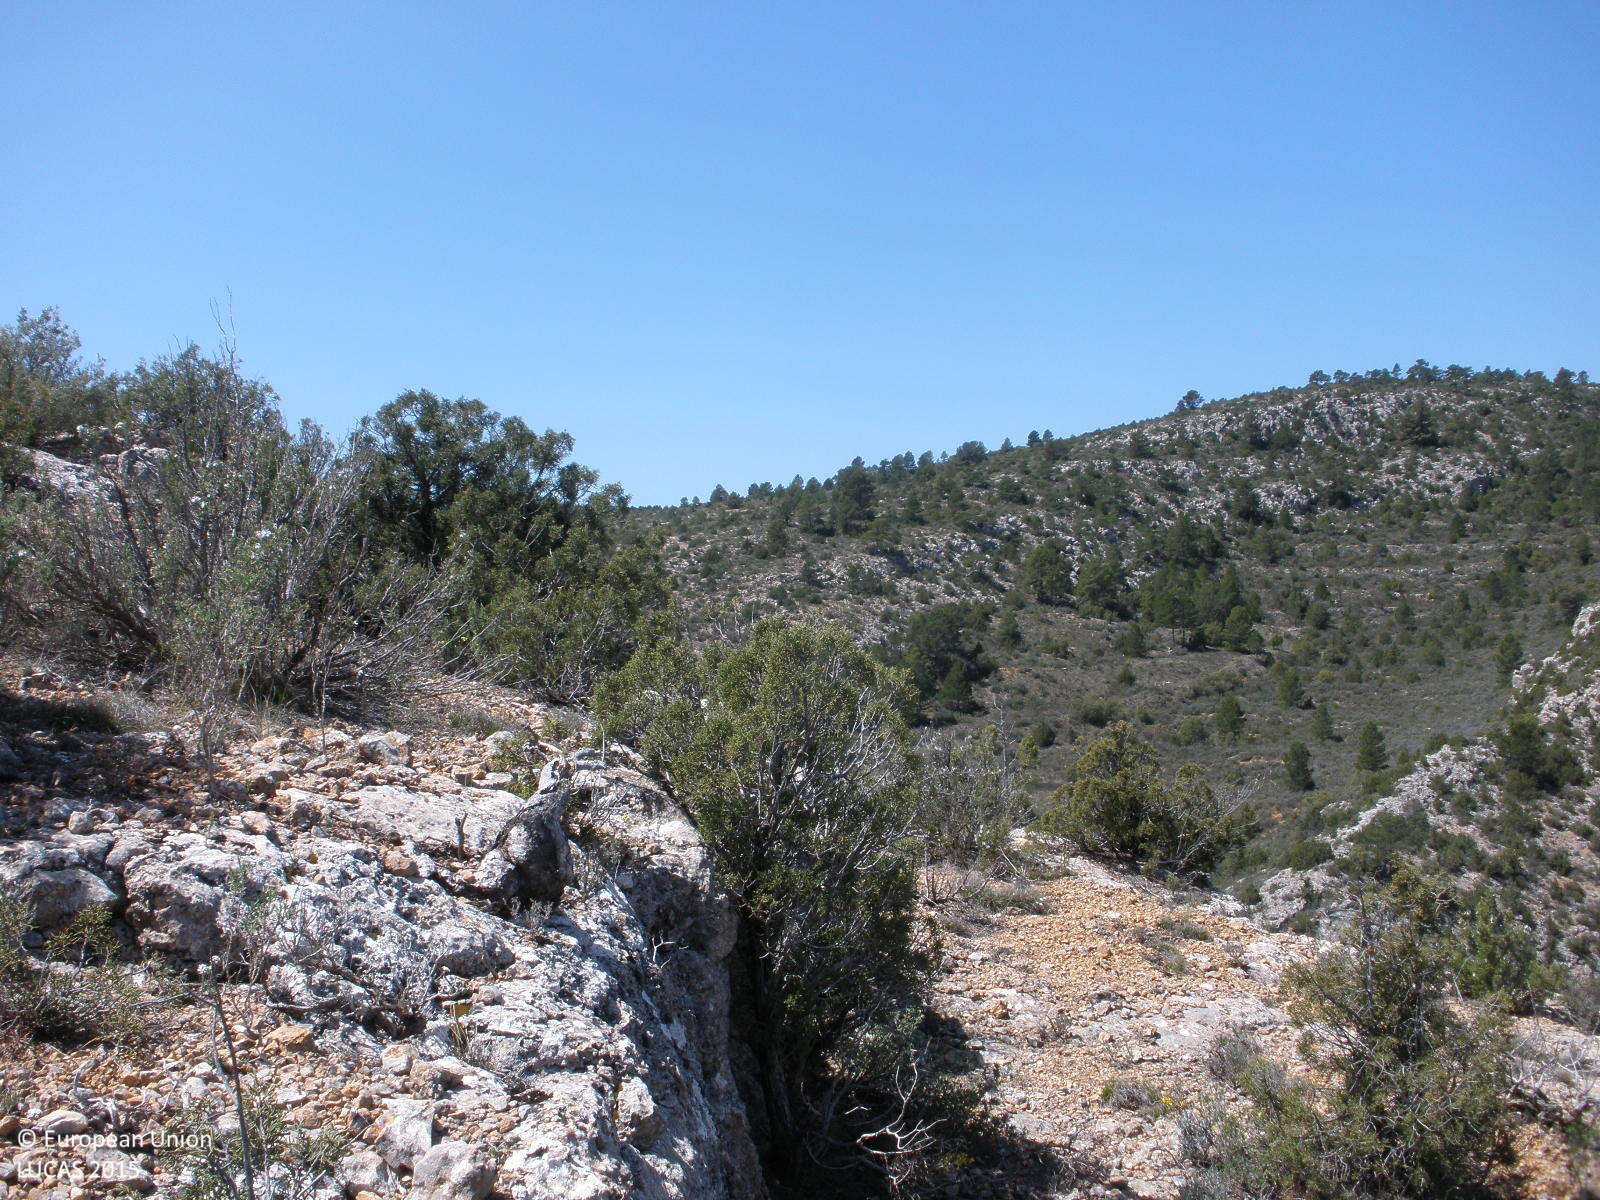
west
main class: Woodland
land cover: Pine dominated coniferous woodland
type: coniferous forest of the mediterranean region
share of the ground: 25 - 50 %
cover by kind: shrubs 50 %, coniferous forest trees 30 %, consolidated bare surface 20 %
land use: Semi-natural and natural areas not in use
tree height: < 5 m
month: April
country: ES
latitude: 40.2018
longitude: -1.2529
